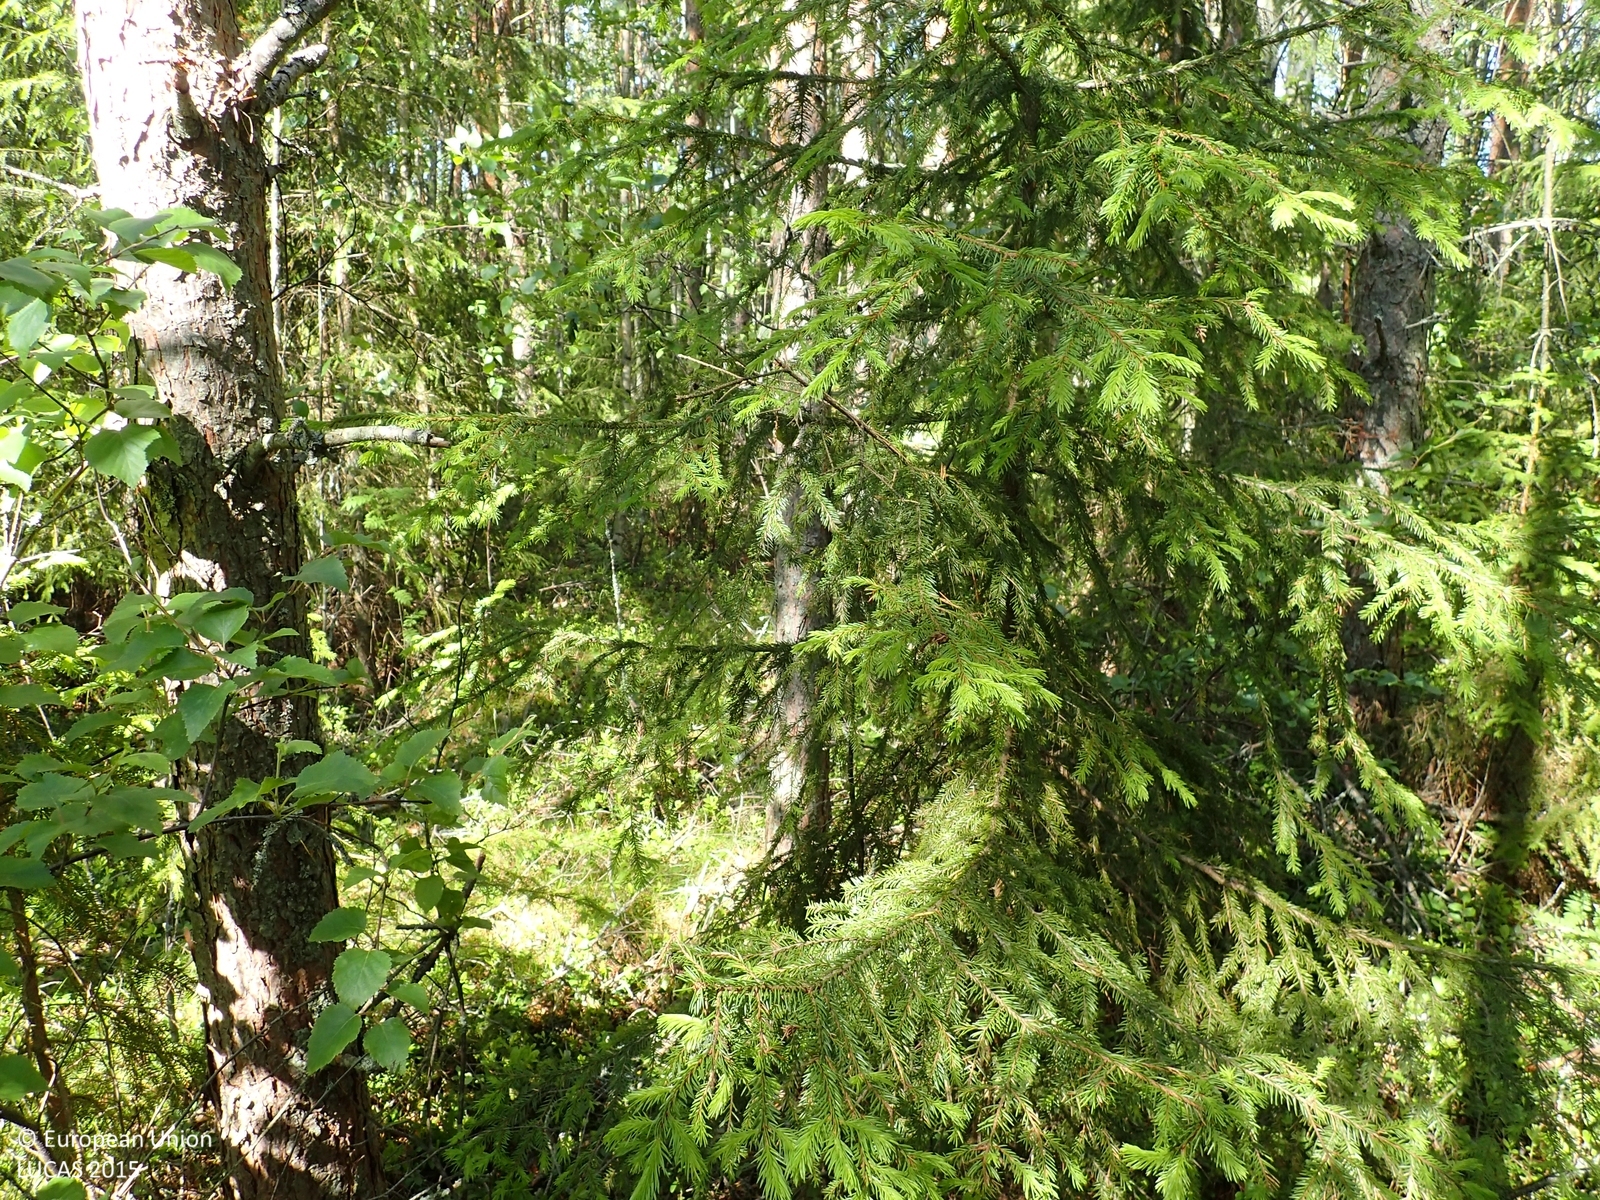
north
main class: Woodland
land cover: Pine dominated mixed woodland
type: boreal forest
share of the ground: > 75 %
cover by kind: coniferous forest trees 60 %, broadleaved forest trees 30 %, shrubs 5 %, herbaceous plants 5 %
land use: Forestry
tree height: > 5 m
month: June
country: FI
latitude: 62.5152
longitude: 21.2865
